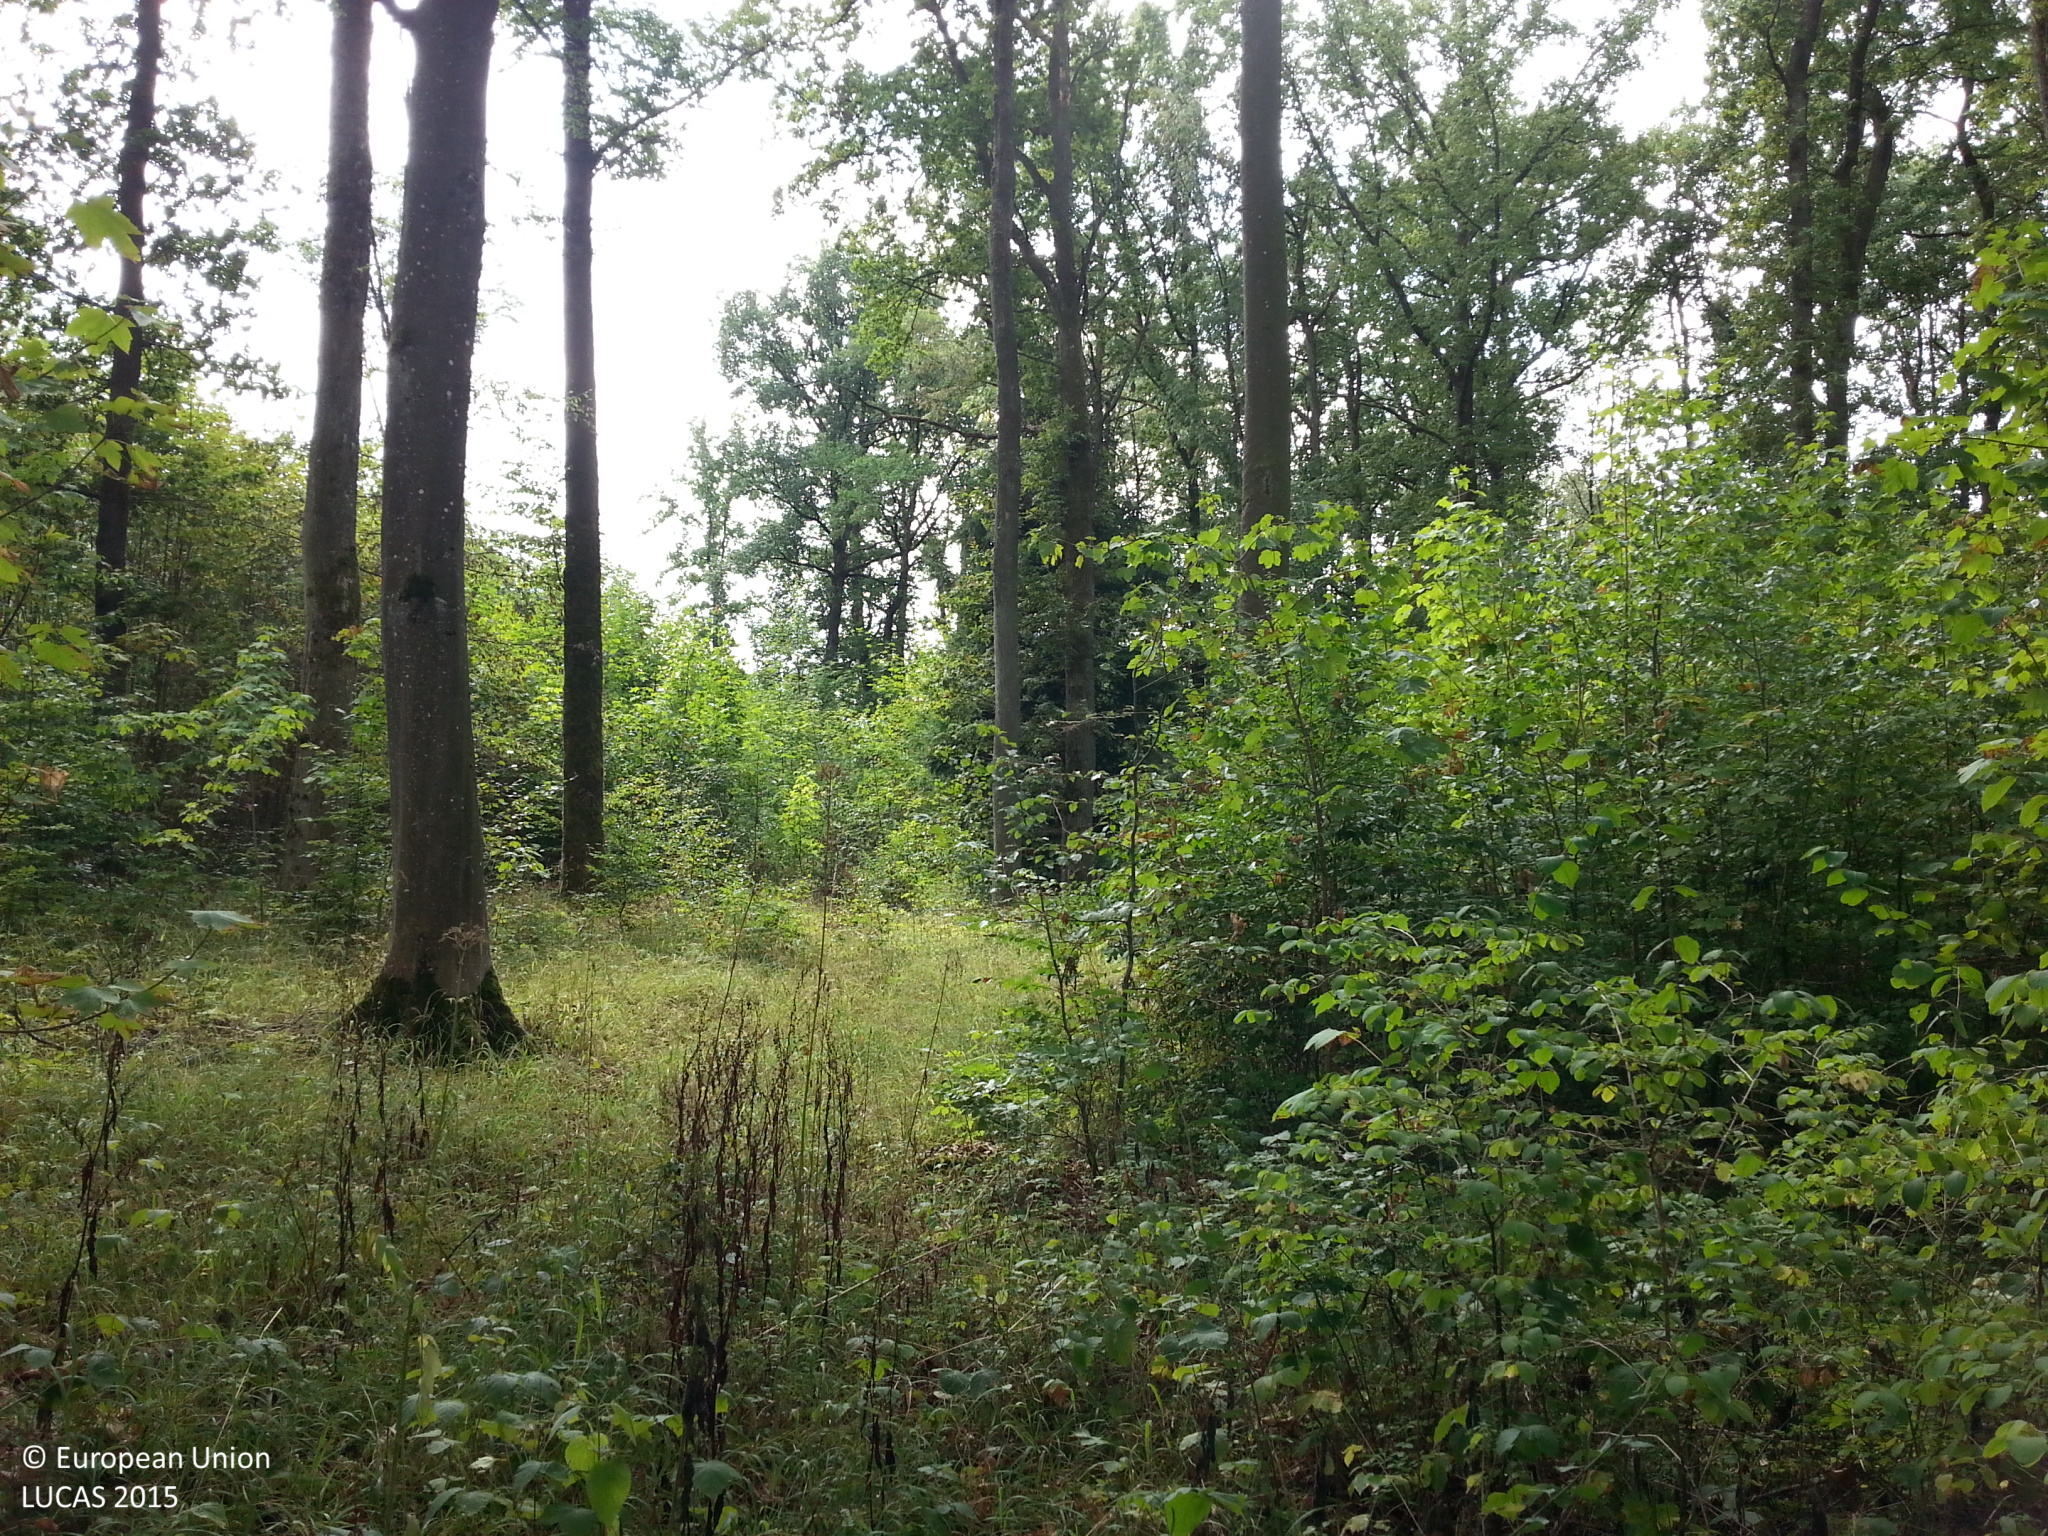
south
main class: Woodland
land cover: Broadleaved woodland
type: acidophilous oak and oak-birch forest
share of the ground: 50 - 75 %
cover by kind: broadleaved forest trees 70 %, shrubs 15 %, herbaceous plants 15 %
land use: Forestry
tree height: > 5 m
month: September
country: DE
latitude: 49.2850
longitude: 9.9038
